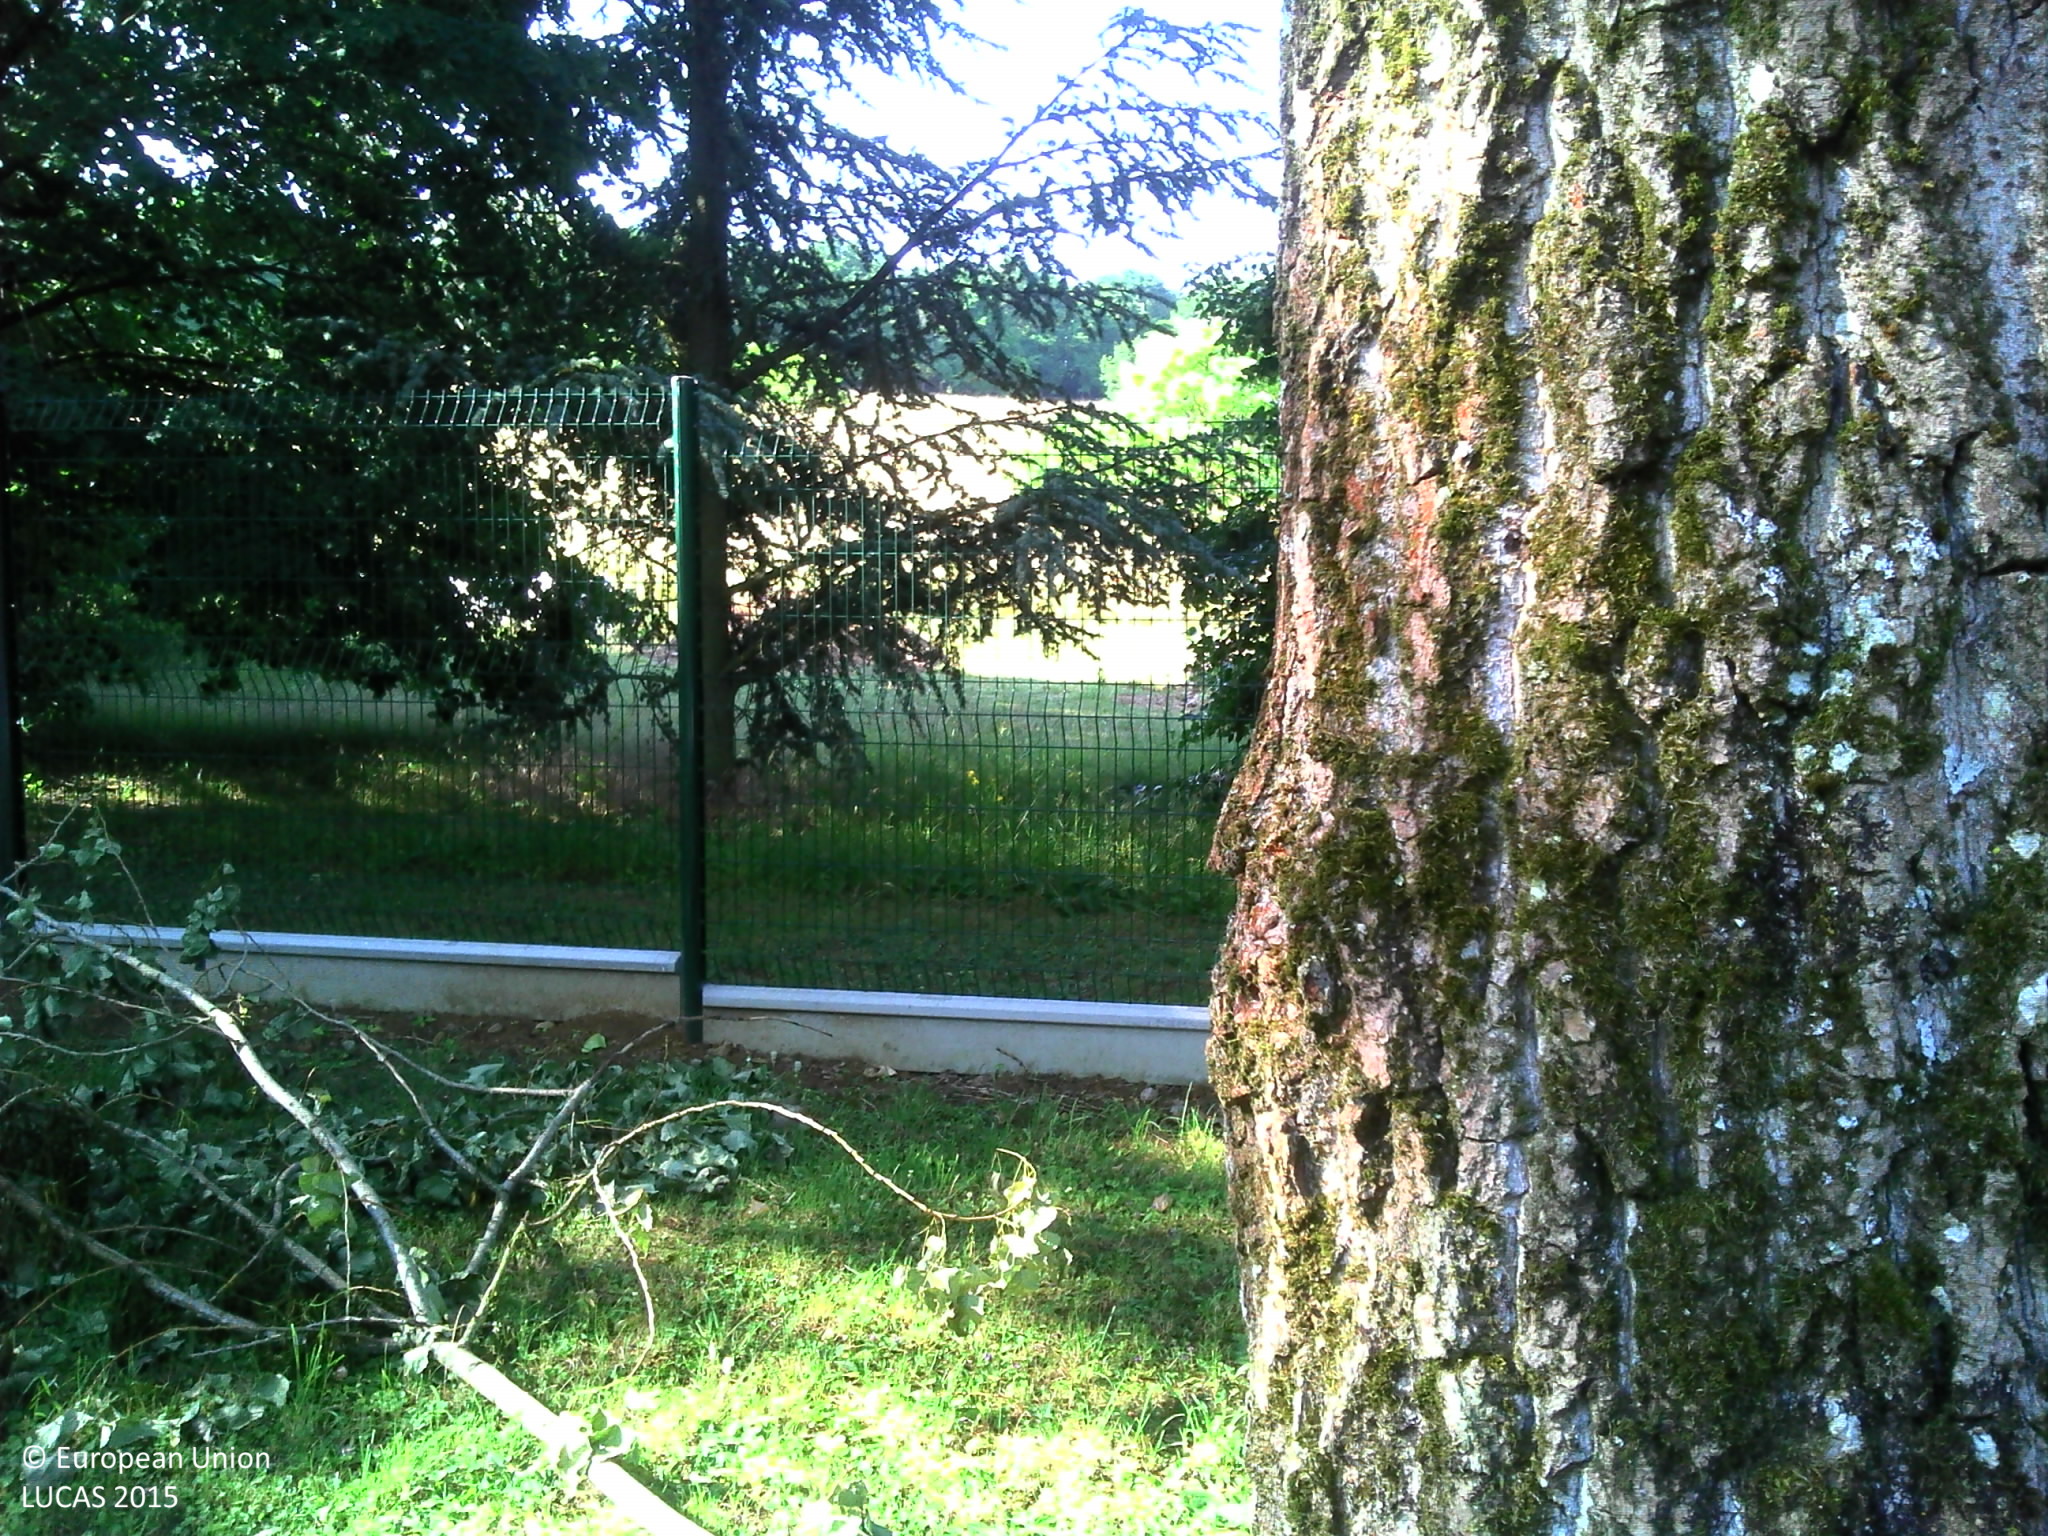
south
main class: Woodland
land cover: Broadleaved woodland
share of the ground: > 75 %
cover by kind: broadleaved forest trees 80 %, herbaceous plants 20 %
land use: Community services
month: July
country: FR
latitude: 48.6610
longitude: 6.1578
